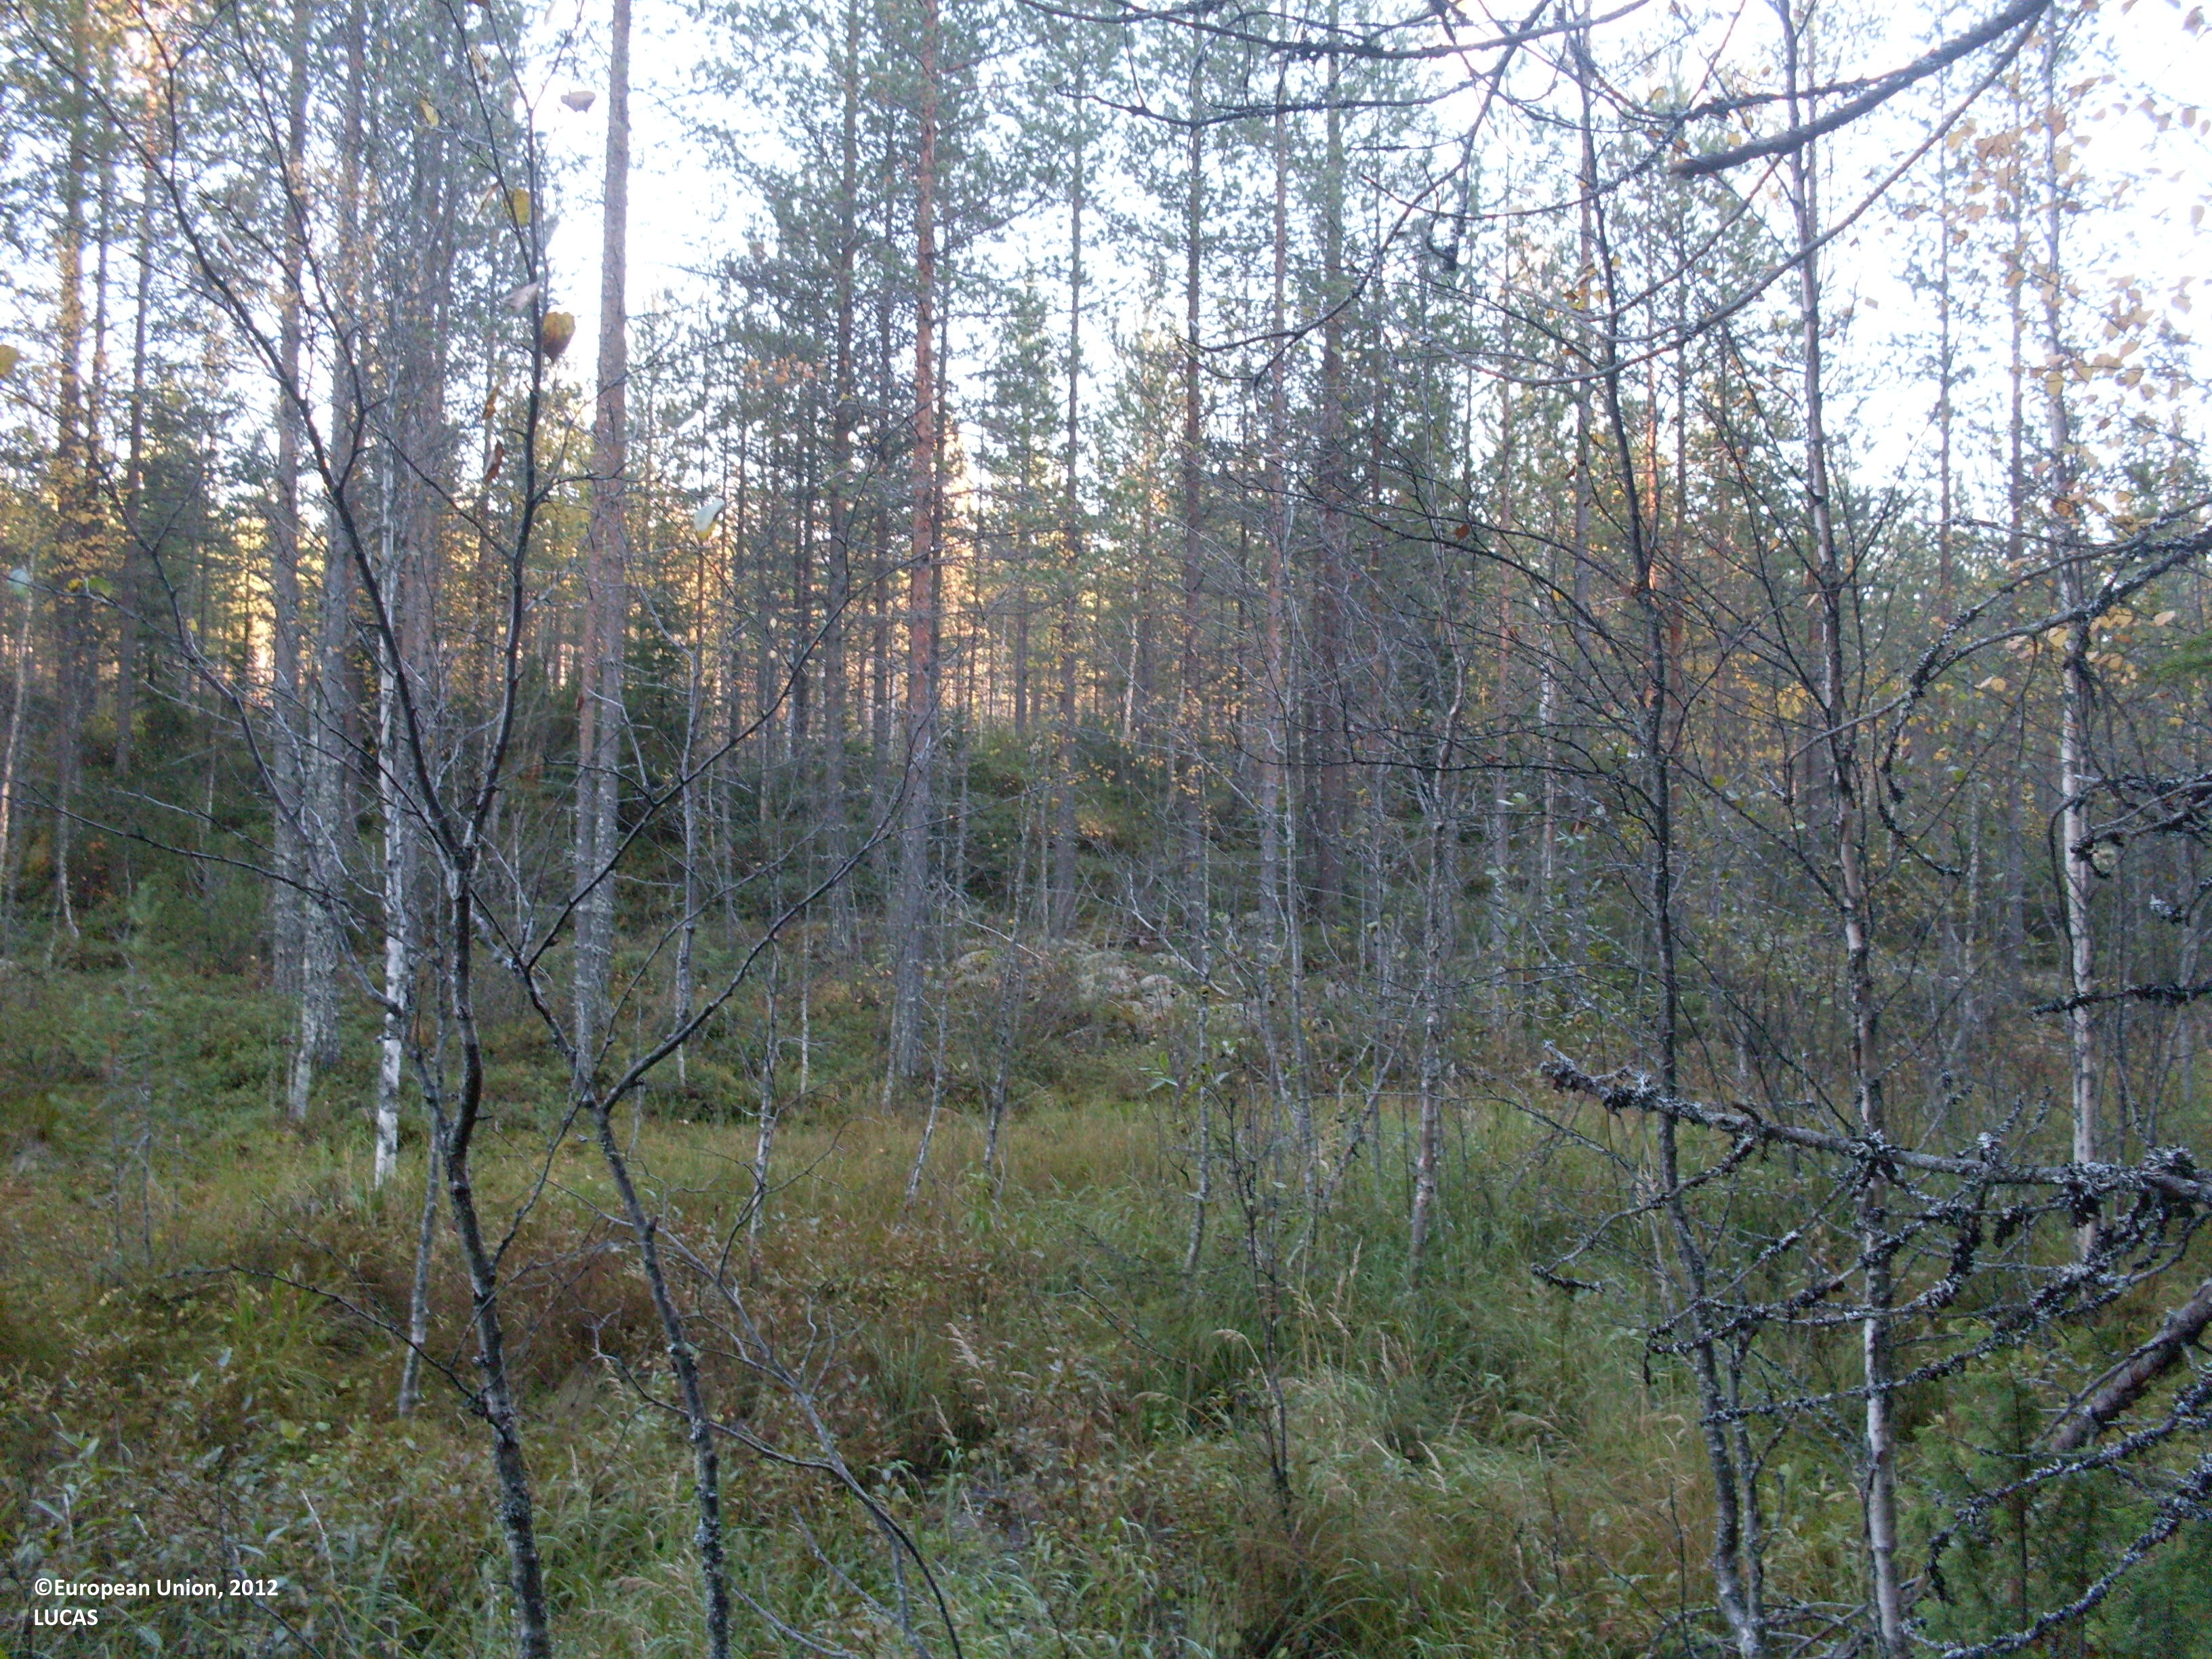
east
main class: Woodland
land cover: Pine dominated mixed woodland
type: boreal forest
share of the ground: > 75 %
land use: Forestry
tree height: > 5 m
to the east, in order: Pine dominated mixed woodland; Peatbogs; Pine dominated mixed woodland
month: September
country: FI
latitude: 64.2130
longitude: 28.6238
